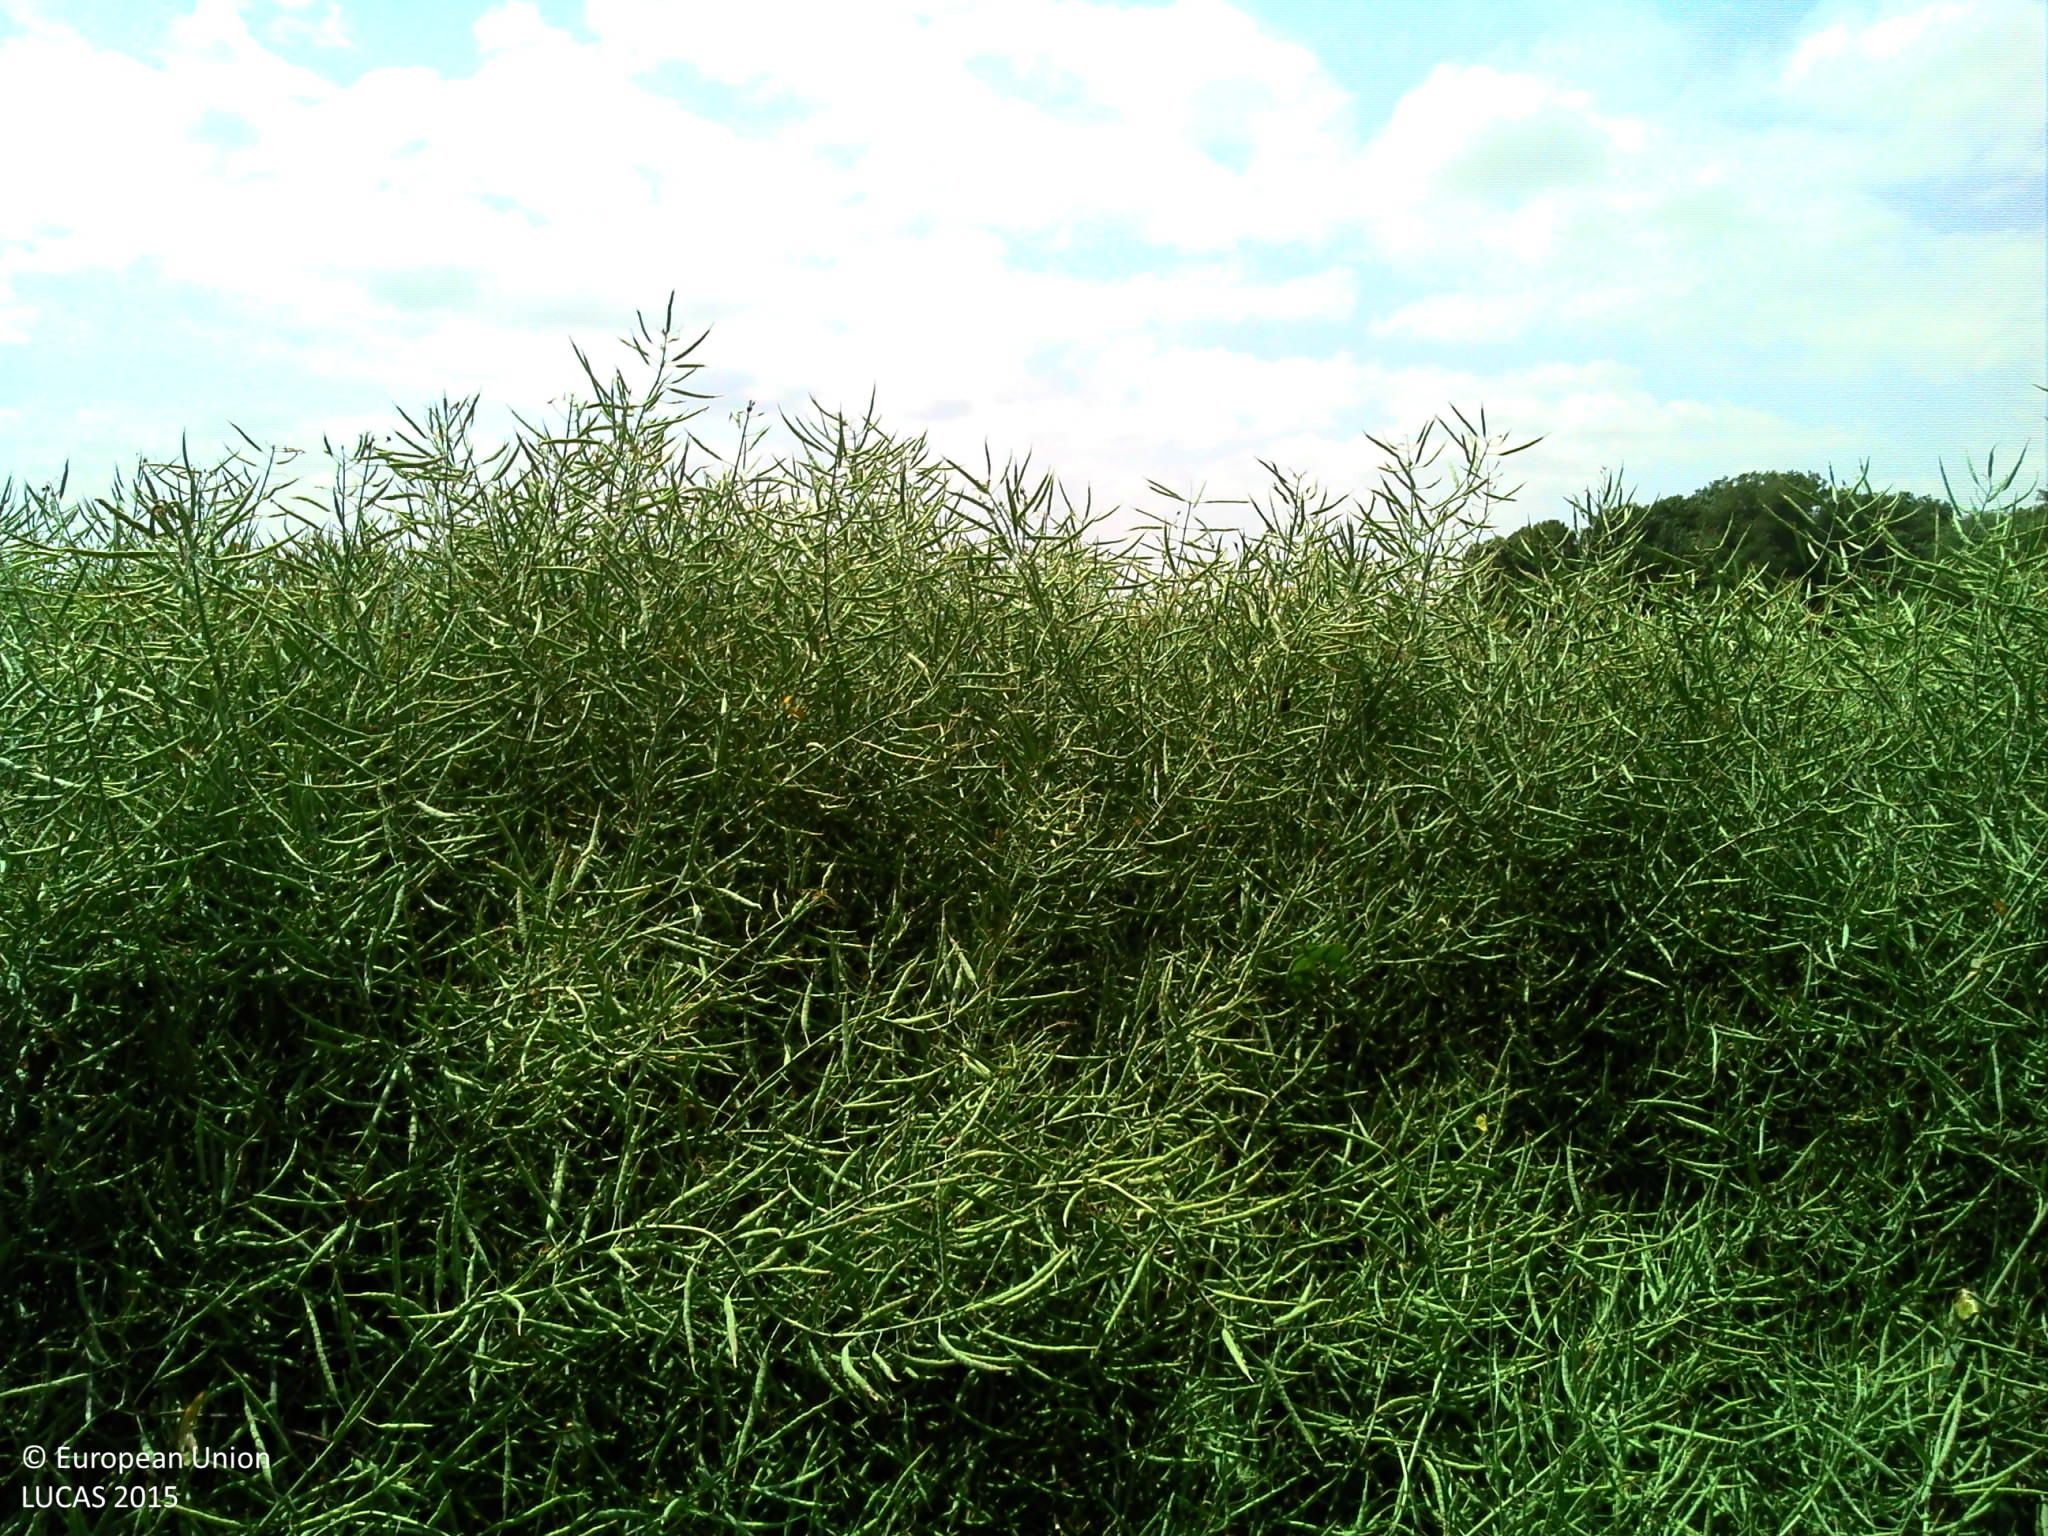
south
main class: Cropland
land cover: Rape and turnip rape
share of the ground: > 75 %
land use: Agriculture (excluding fallow land and kitchen gardens)
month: June
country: FR
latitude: 47.3303
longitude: 5.3032
